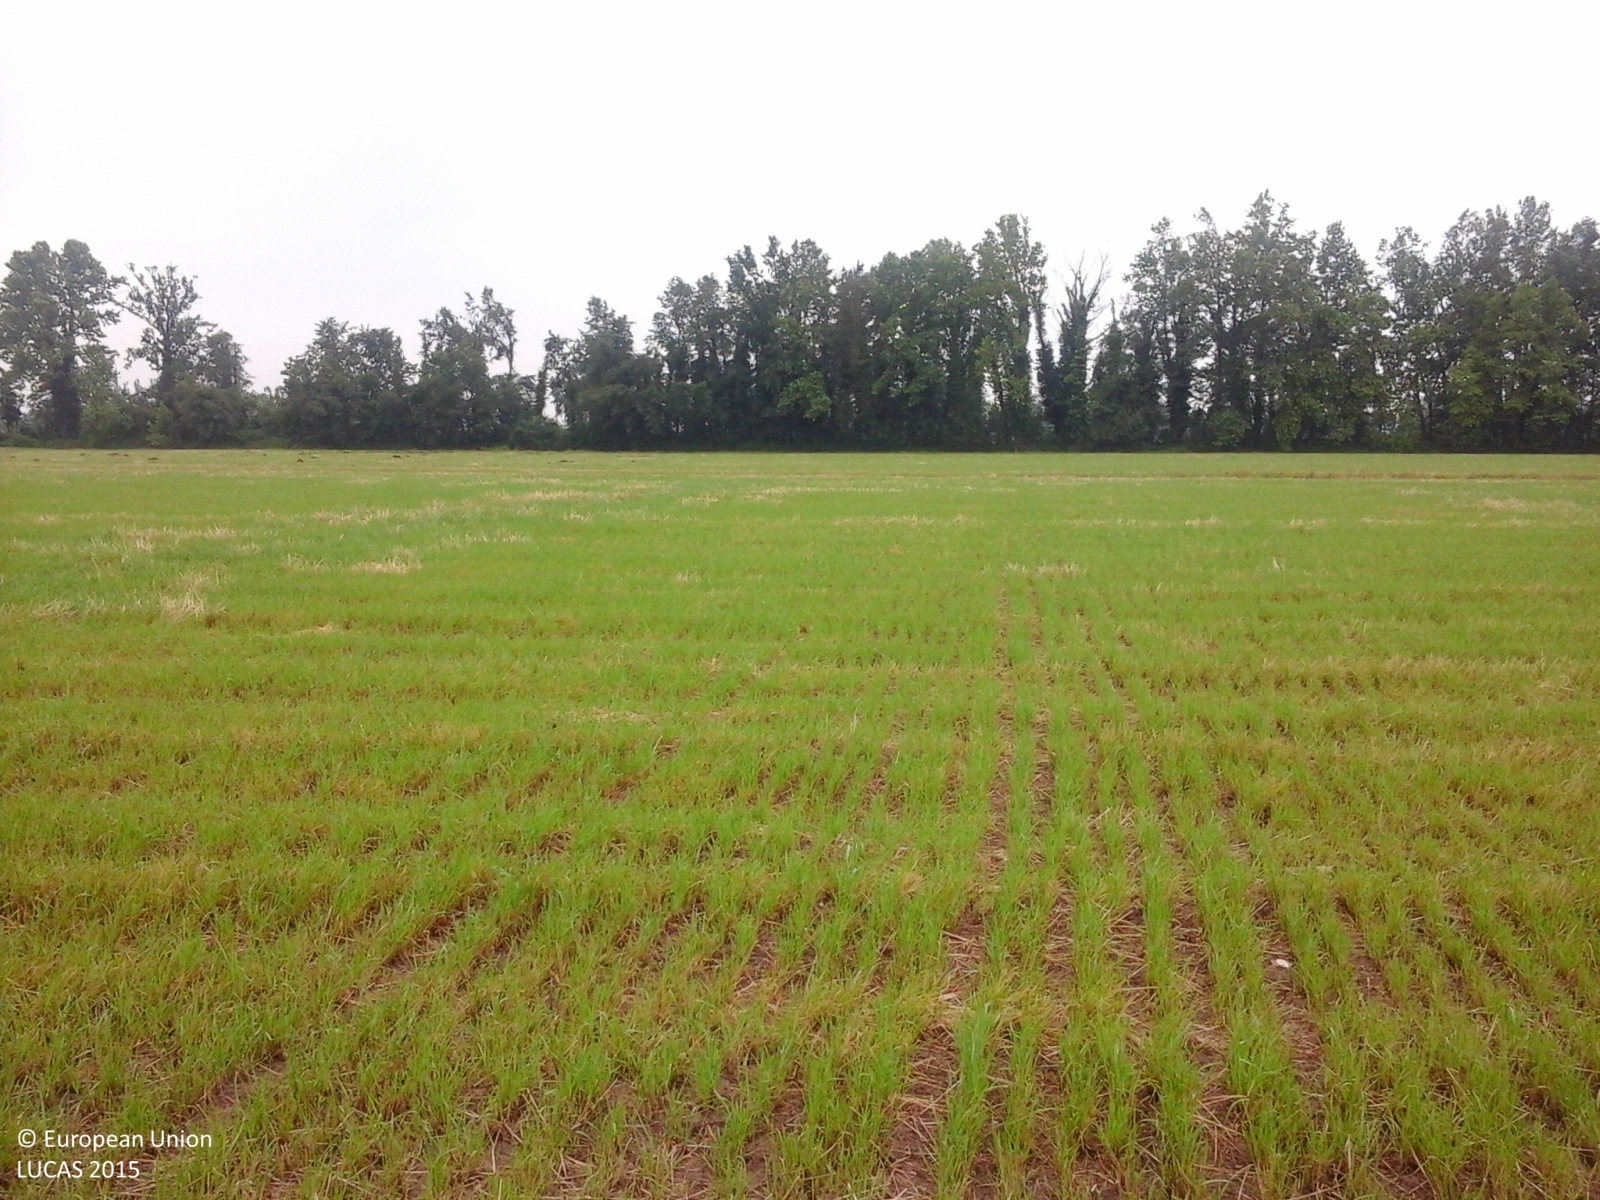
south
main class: Cropland
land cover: Temporary grasslands
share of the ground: > 75 %
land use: Agriculture (excluding fallow land and kitchen gardens)
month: May
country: IT
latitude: 45.2160
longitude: 10.0635
